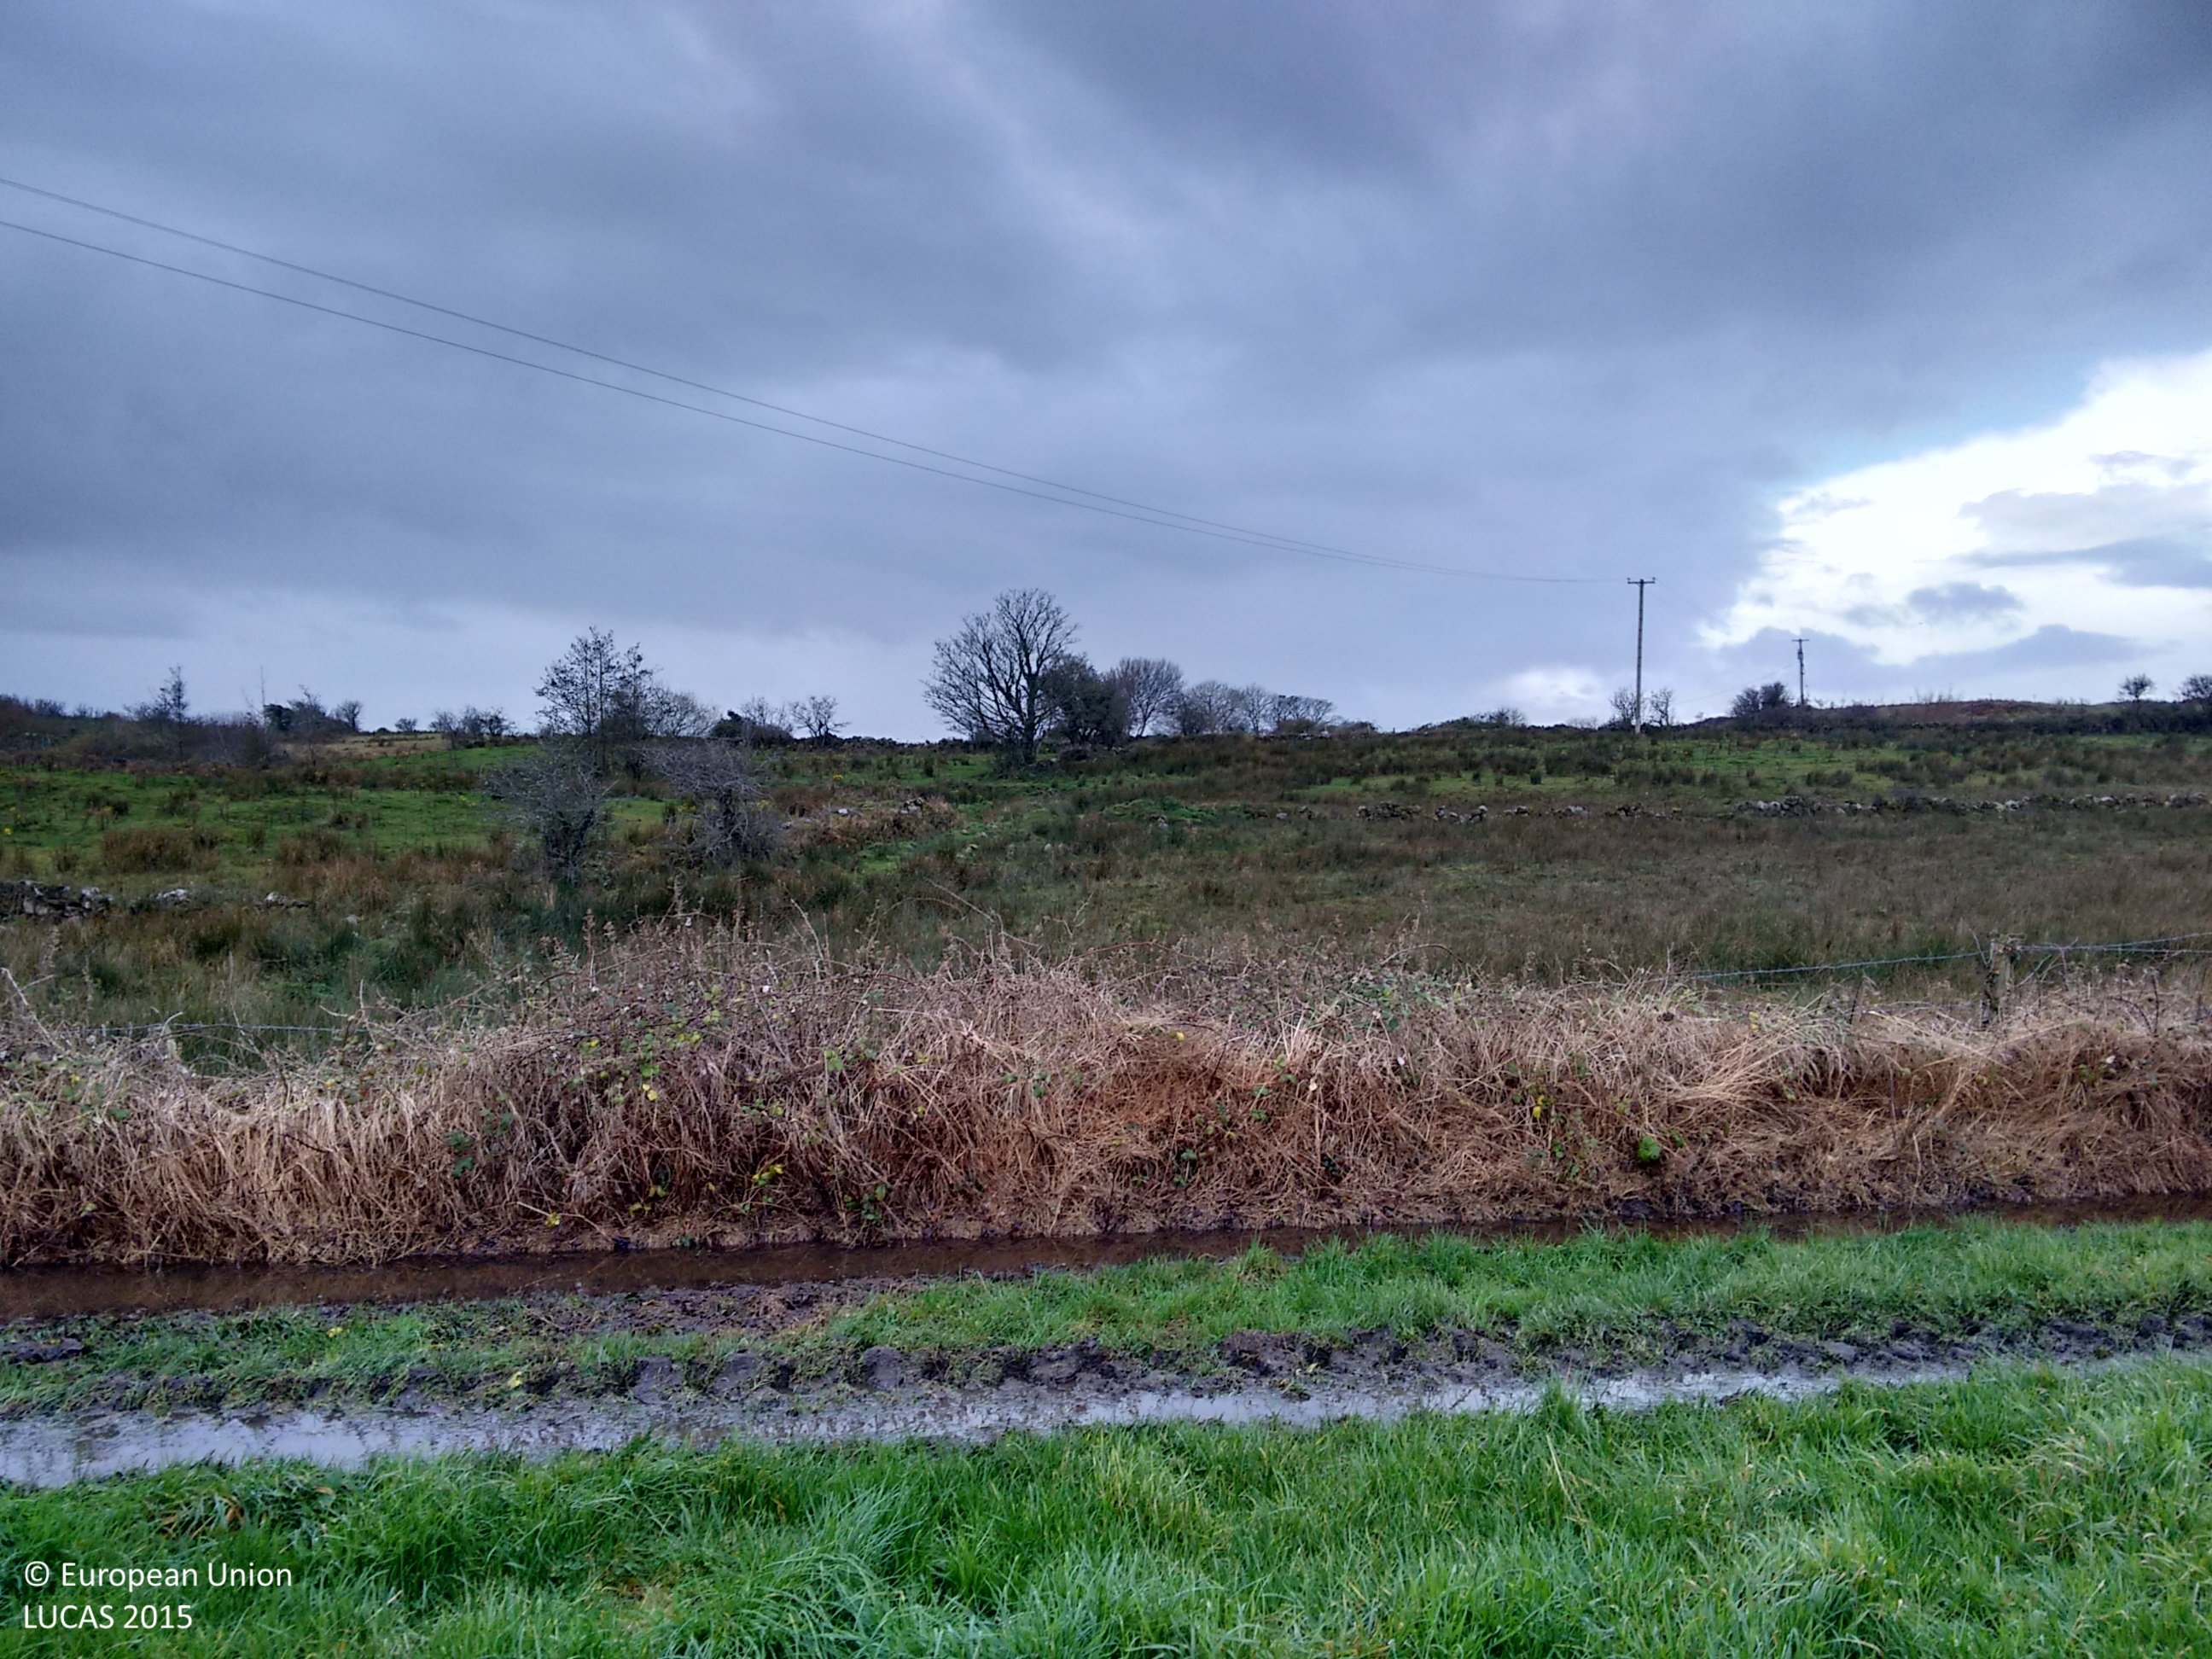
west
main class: Grassland
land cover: Grassland without tree/shrub cover
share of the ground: > 75 %
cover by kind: herbaceous plants 100 %
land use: Agriculture (excluding fallow land and kitchen gardens)
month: November
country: IE
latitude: 54.4590
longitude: -8.3417
